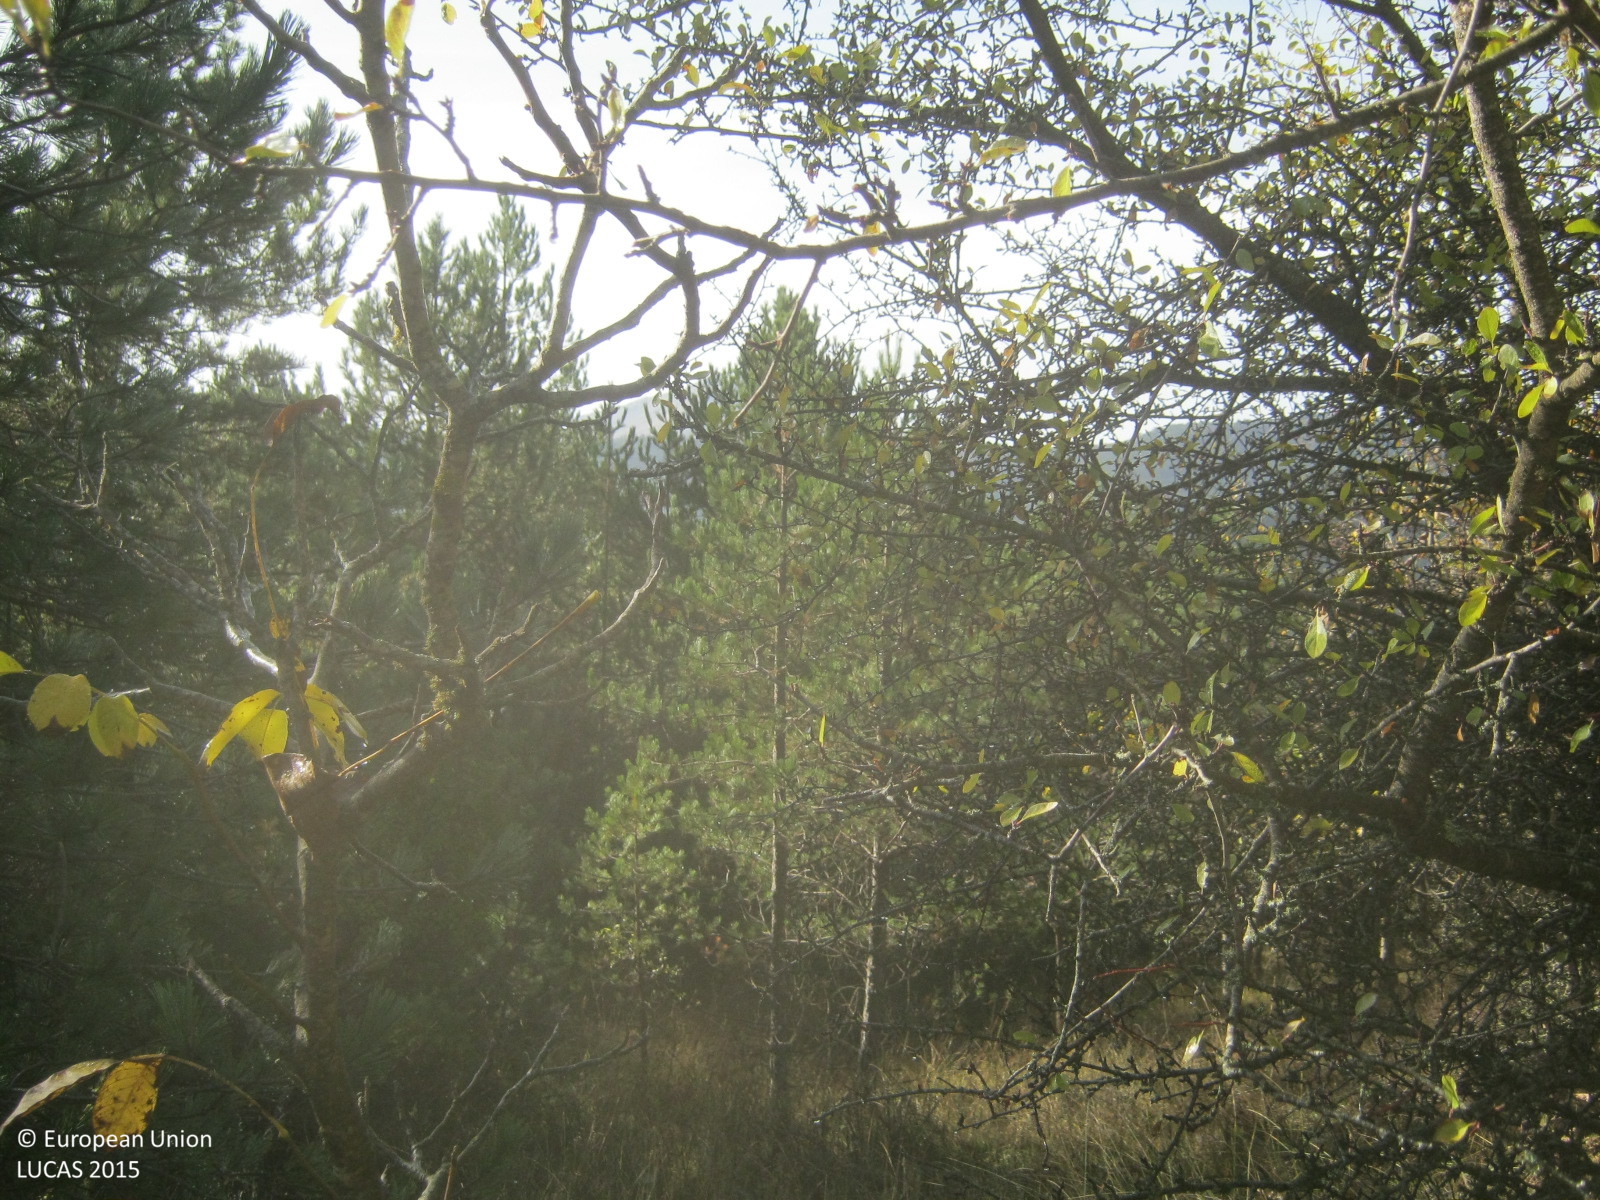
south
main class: Woodland
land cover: Pine dominated mixed woodland
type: coniferous forest of the mediterranean region
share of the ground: > 75 %
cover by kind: coniferous forest trees 60 %, broadleaved forest trees 25 %, herbaceous plants 15 %
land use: Forestry
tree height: > 5 m
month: October
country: GR
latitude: 38.0112
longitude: 22.4180
